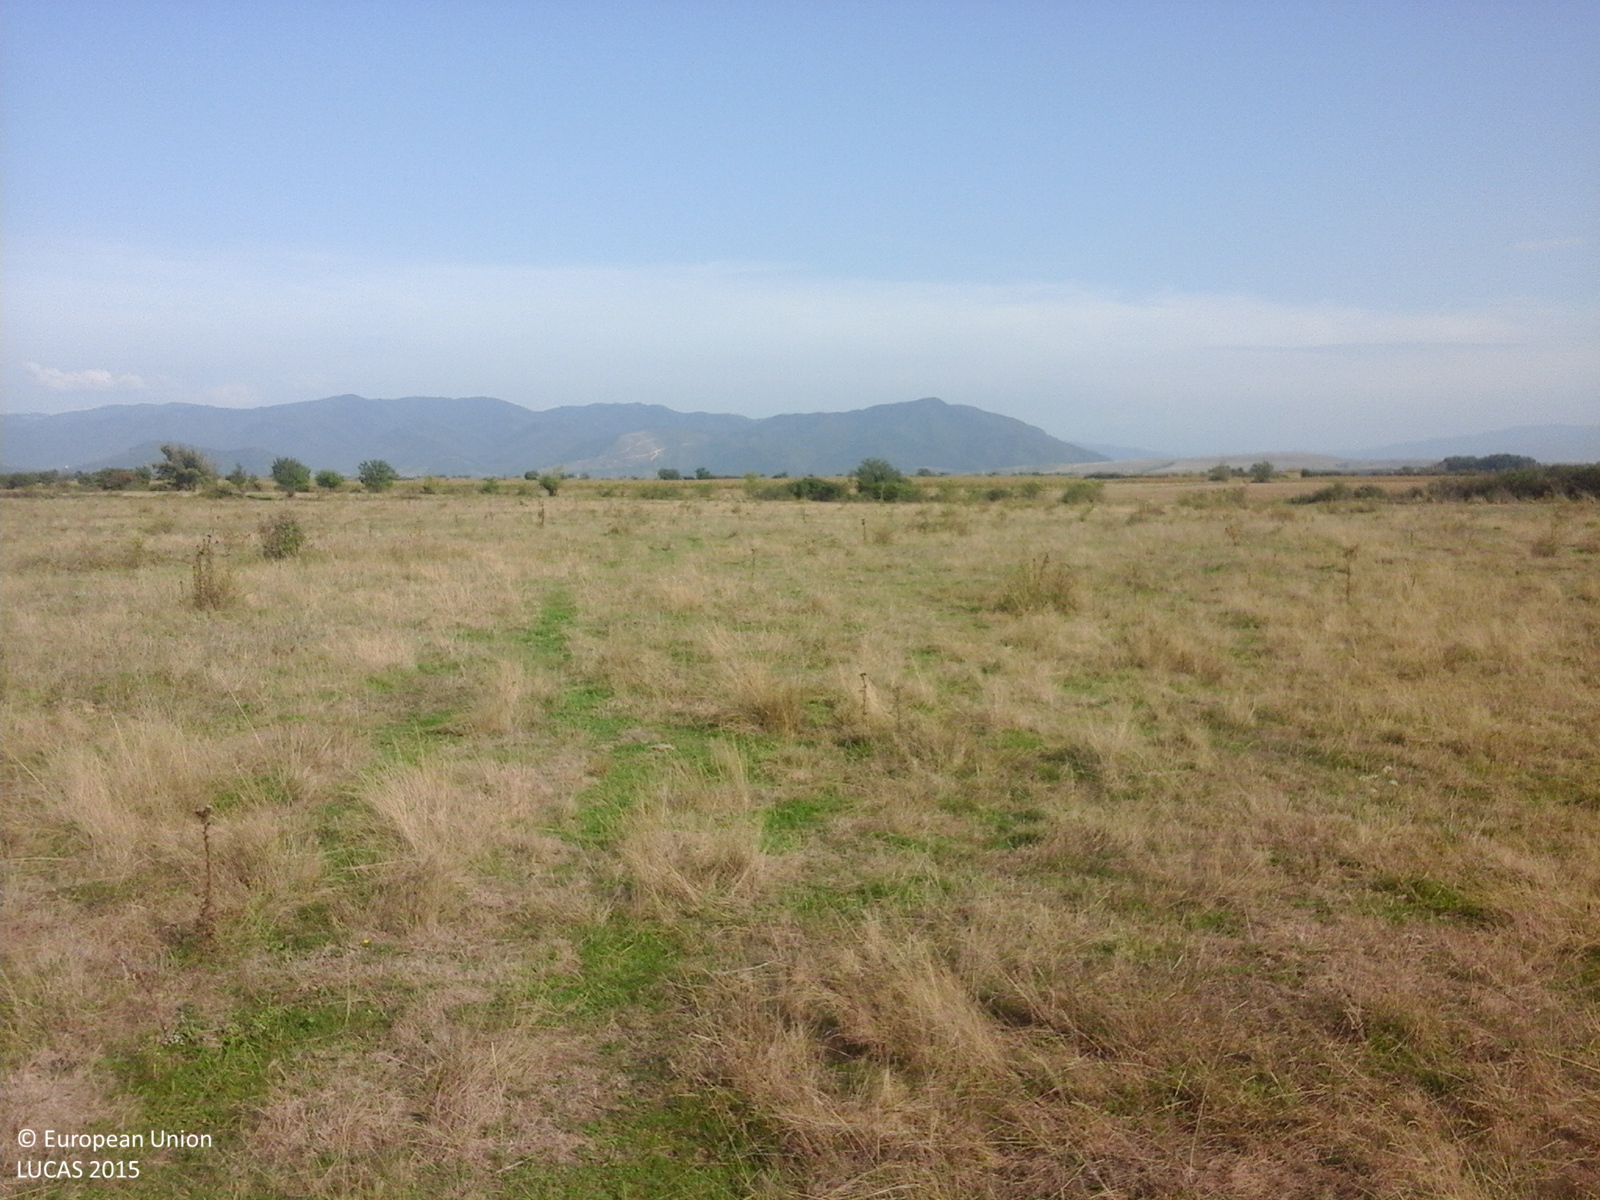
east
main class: Grassland
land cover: Grassland without tree/shrub cover
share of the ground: > 75 %
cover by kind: herbaceous plants 100 %
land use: Agriculture (excluding fallow land and kitchen gardens)
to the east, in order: Grassland without tree/shrub cover; Ditches and canals; Abandoned hedges; Grassland without tree/shrub cover
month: September
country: RO
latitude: 45.5867
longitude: 22.8818
